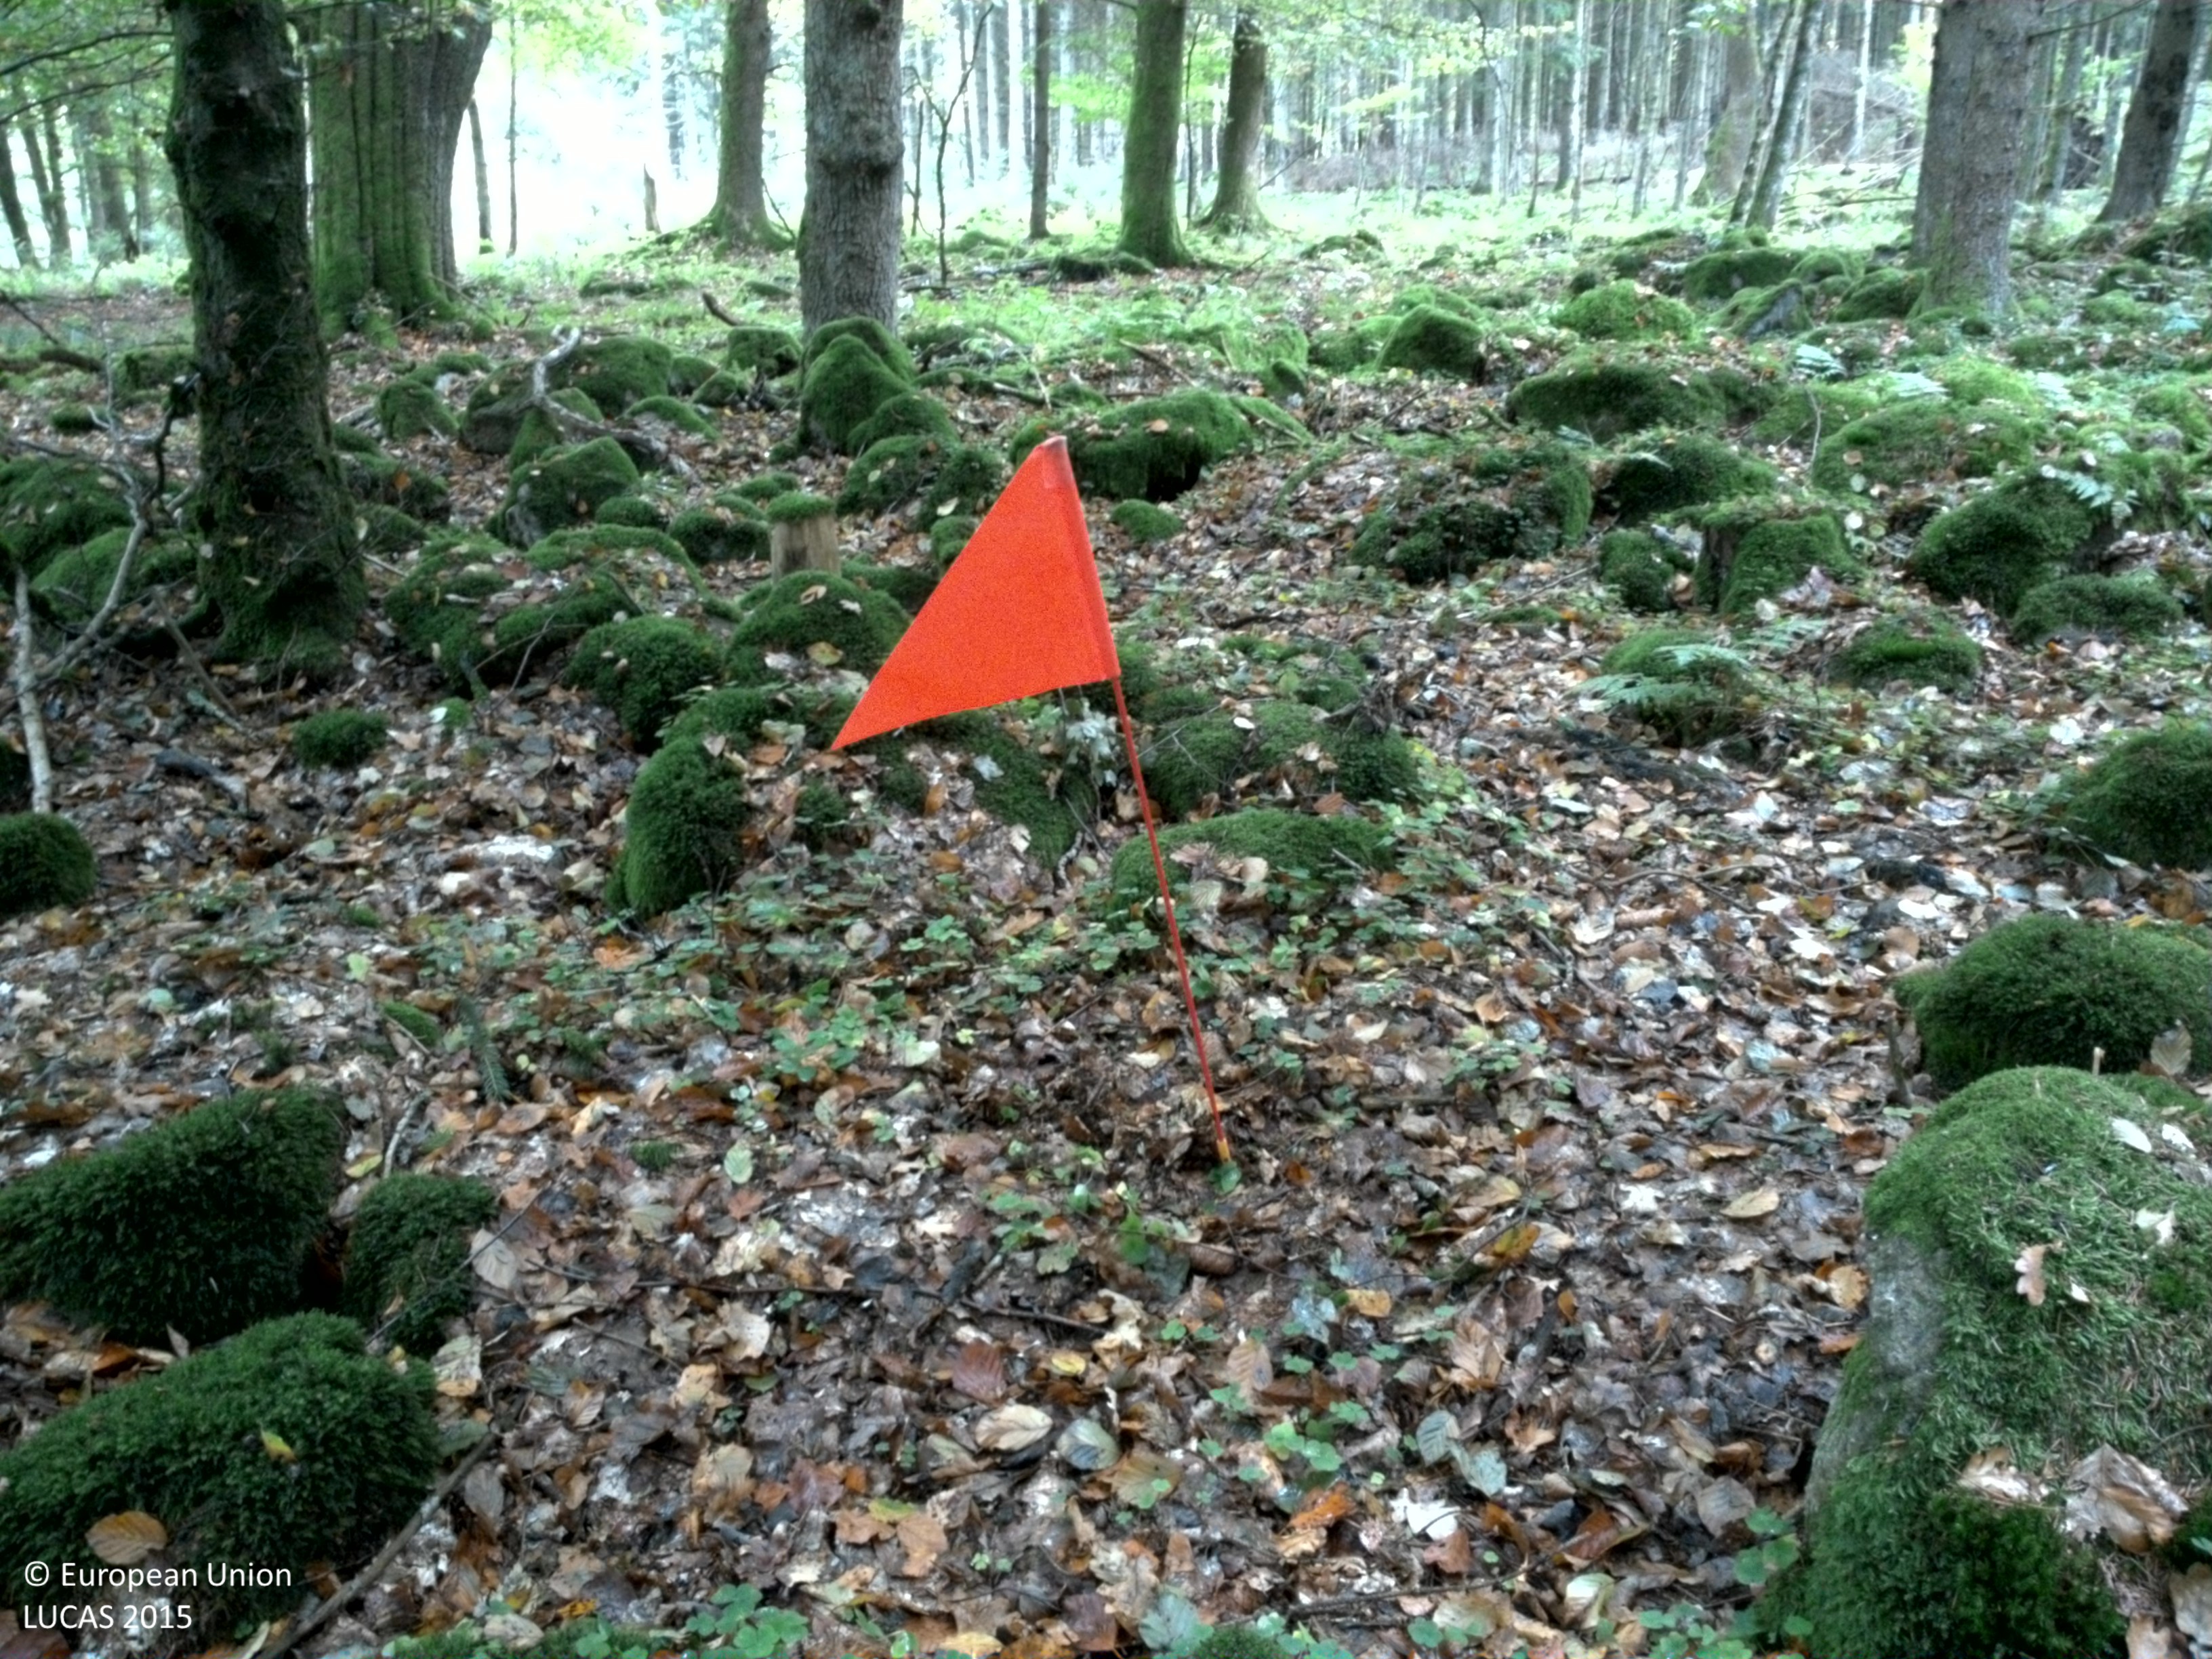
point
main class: Woodland
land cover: Broadleaved woodland
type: mesophytic deciduous forest
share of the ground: > 75 %
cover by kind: broadleaved forest trees 75 %, coniferous forest trees 5 %, shrubs 5 %, herbaceous plants 5 %, lichens and mosses 5 %, unconsolidated bare surface 5 %
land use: Forestry
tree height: > 5 m
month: October
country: SE
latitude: 55.6938
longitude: 13.9914
